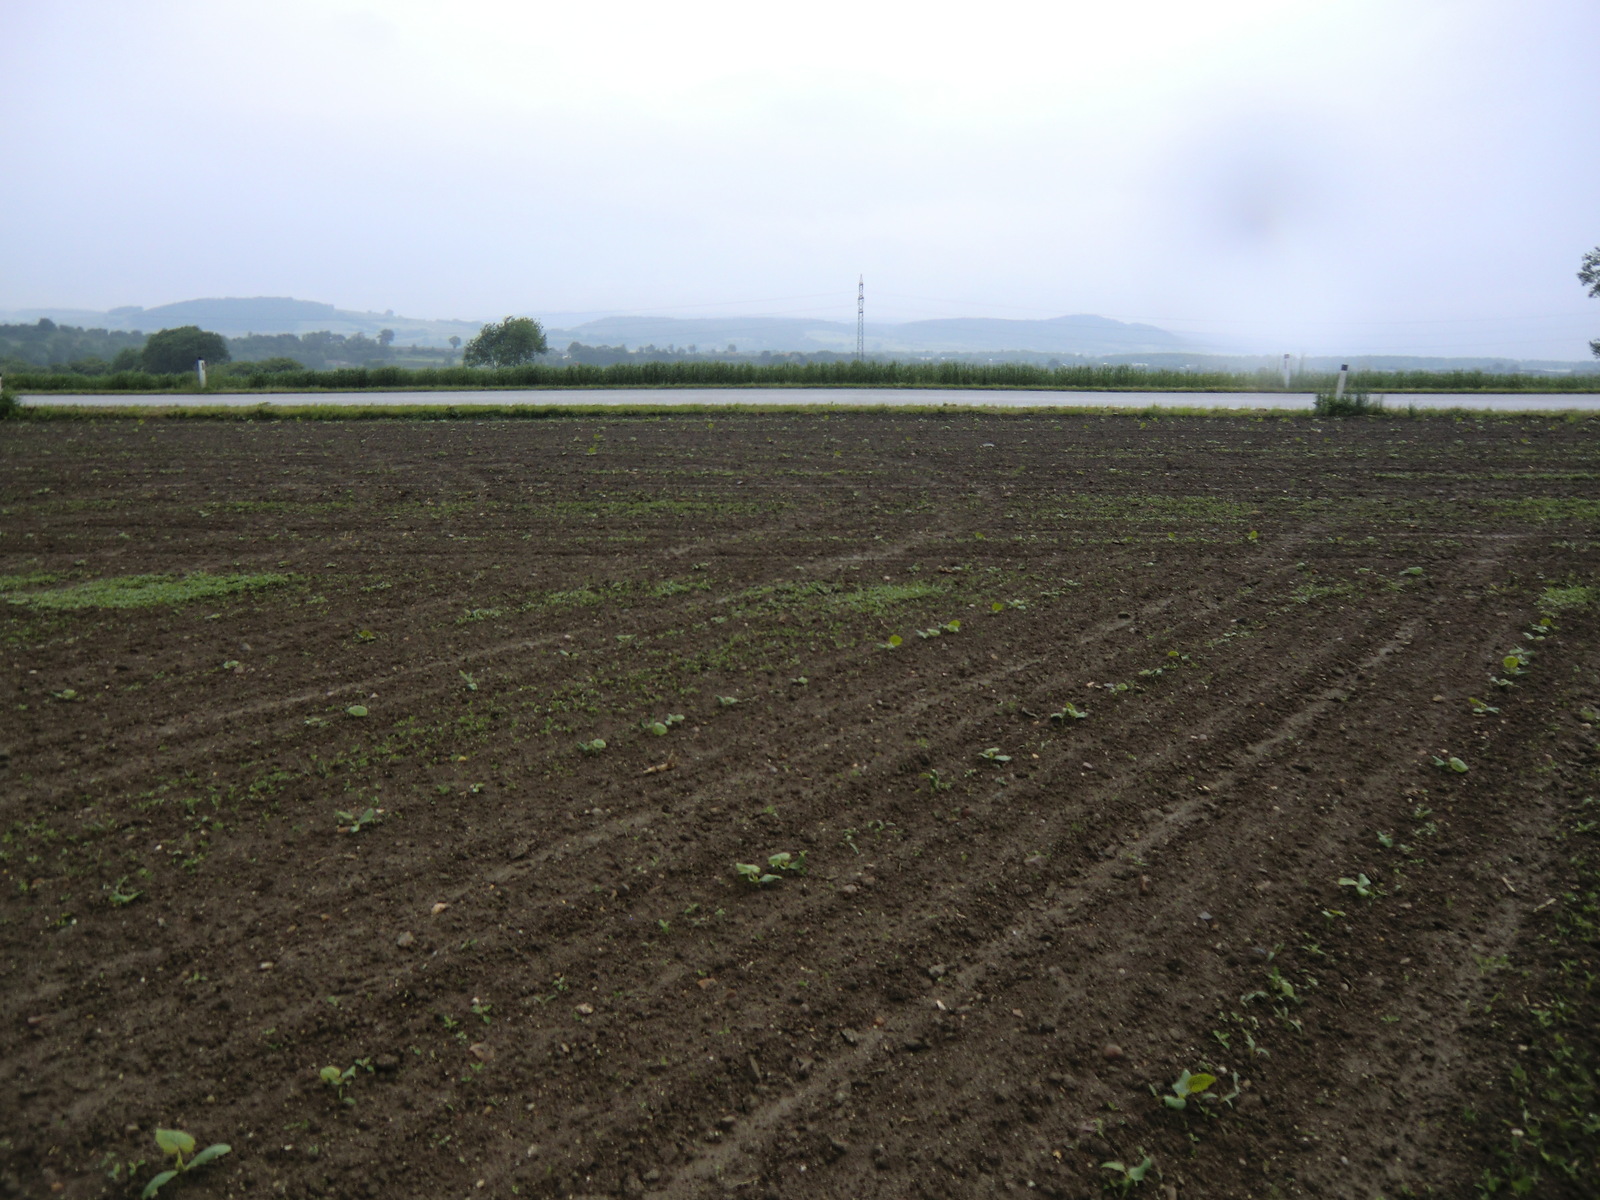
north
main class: Cropland
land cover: Other fibre and oleaginous crops
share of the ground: 25 - 50 %
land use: Agriculture (excluding fallow land and kitchen gardens)
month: May
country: AT
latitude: 48.2048
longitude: 15.2899
